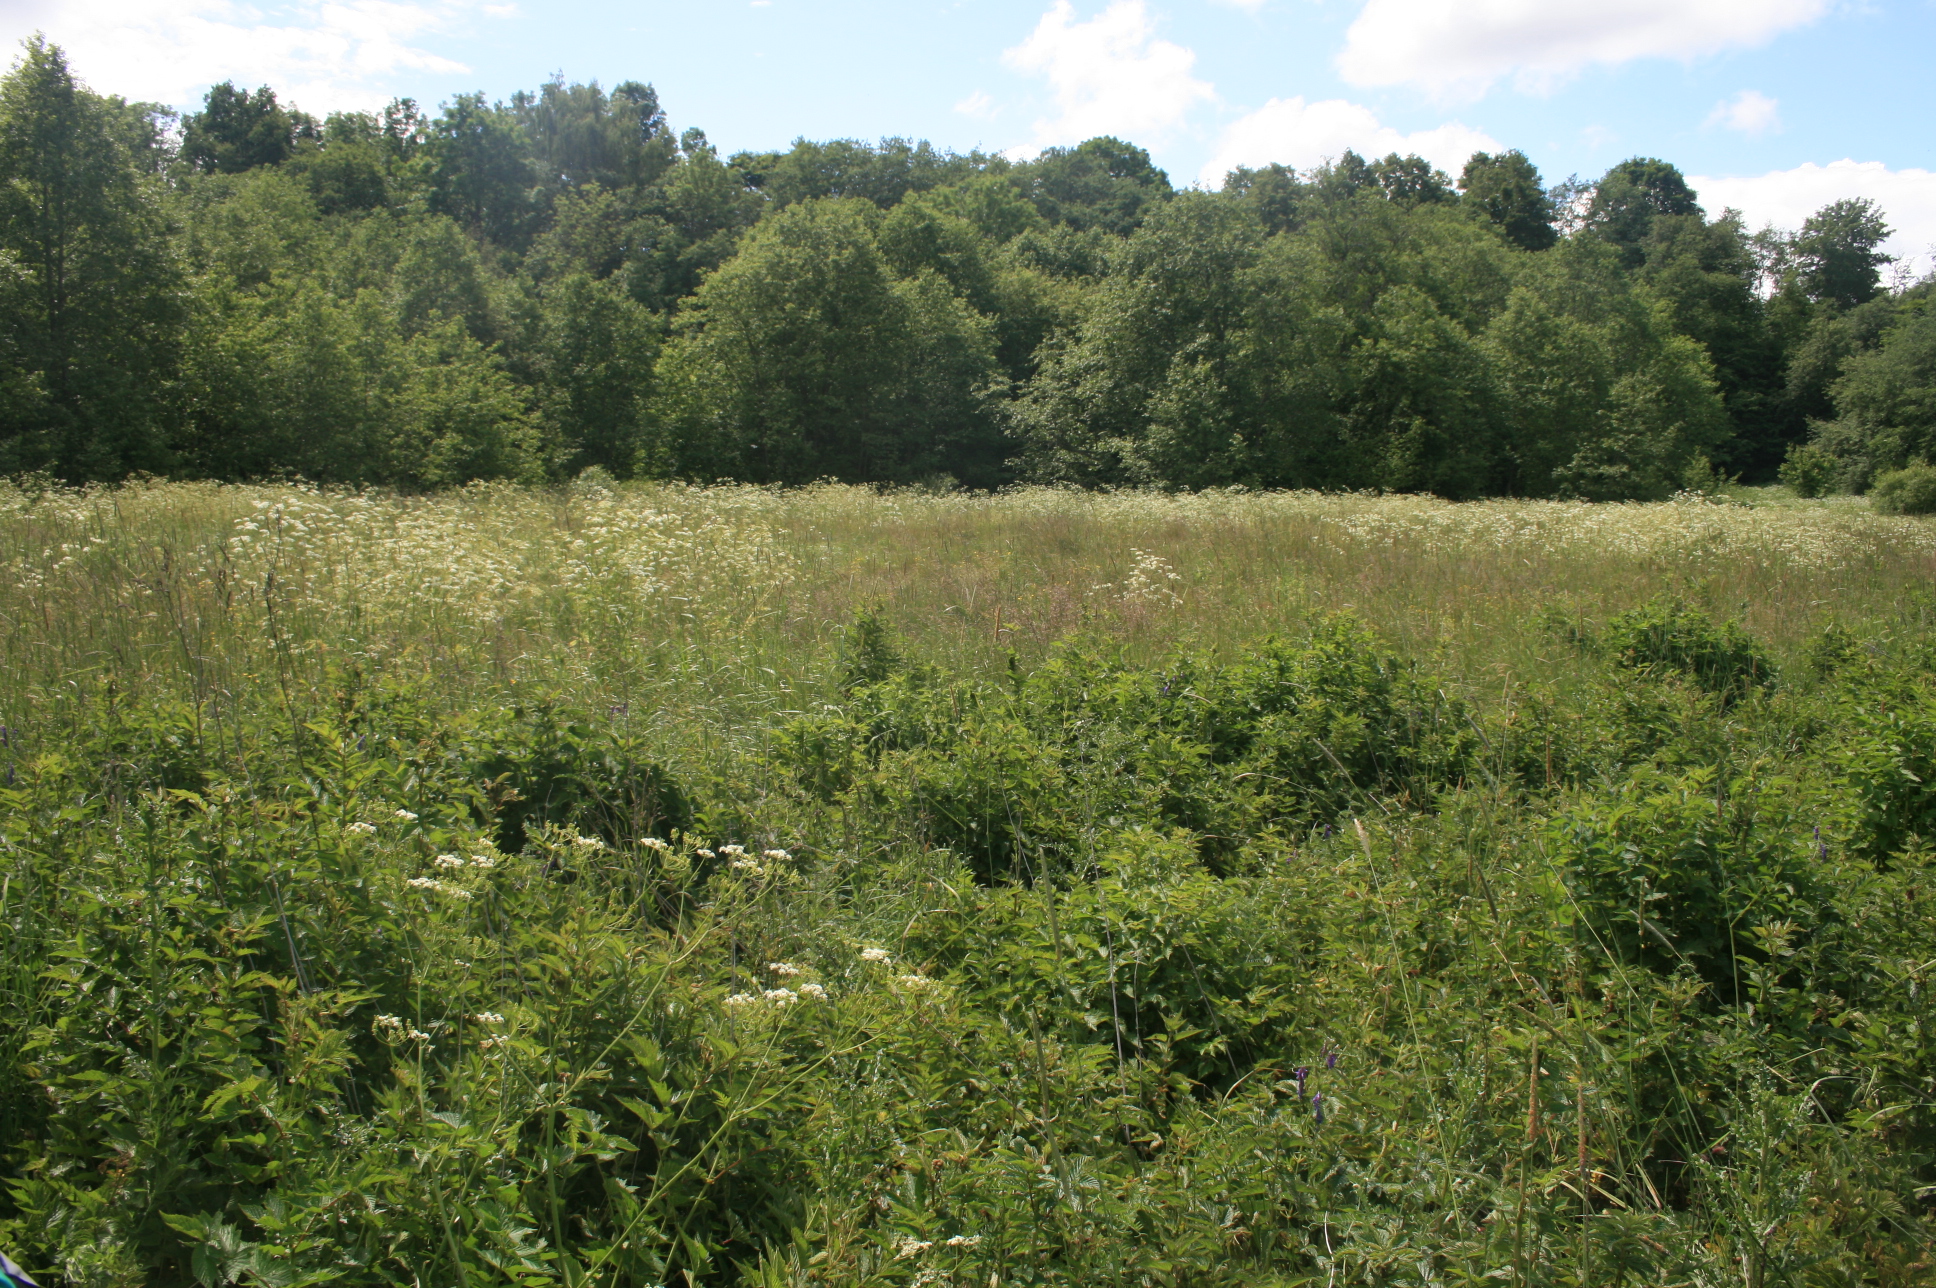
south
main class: Grassland
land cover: Spontaneously vegetated surfaces
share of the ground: > 75 %
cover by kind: herbaceous plants 100 %
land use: Fallow land
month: June
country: LT
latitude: 55.2643
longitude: 22.1258
